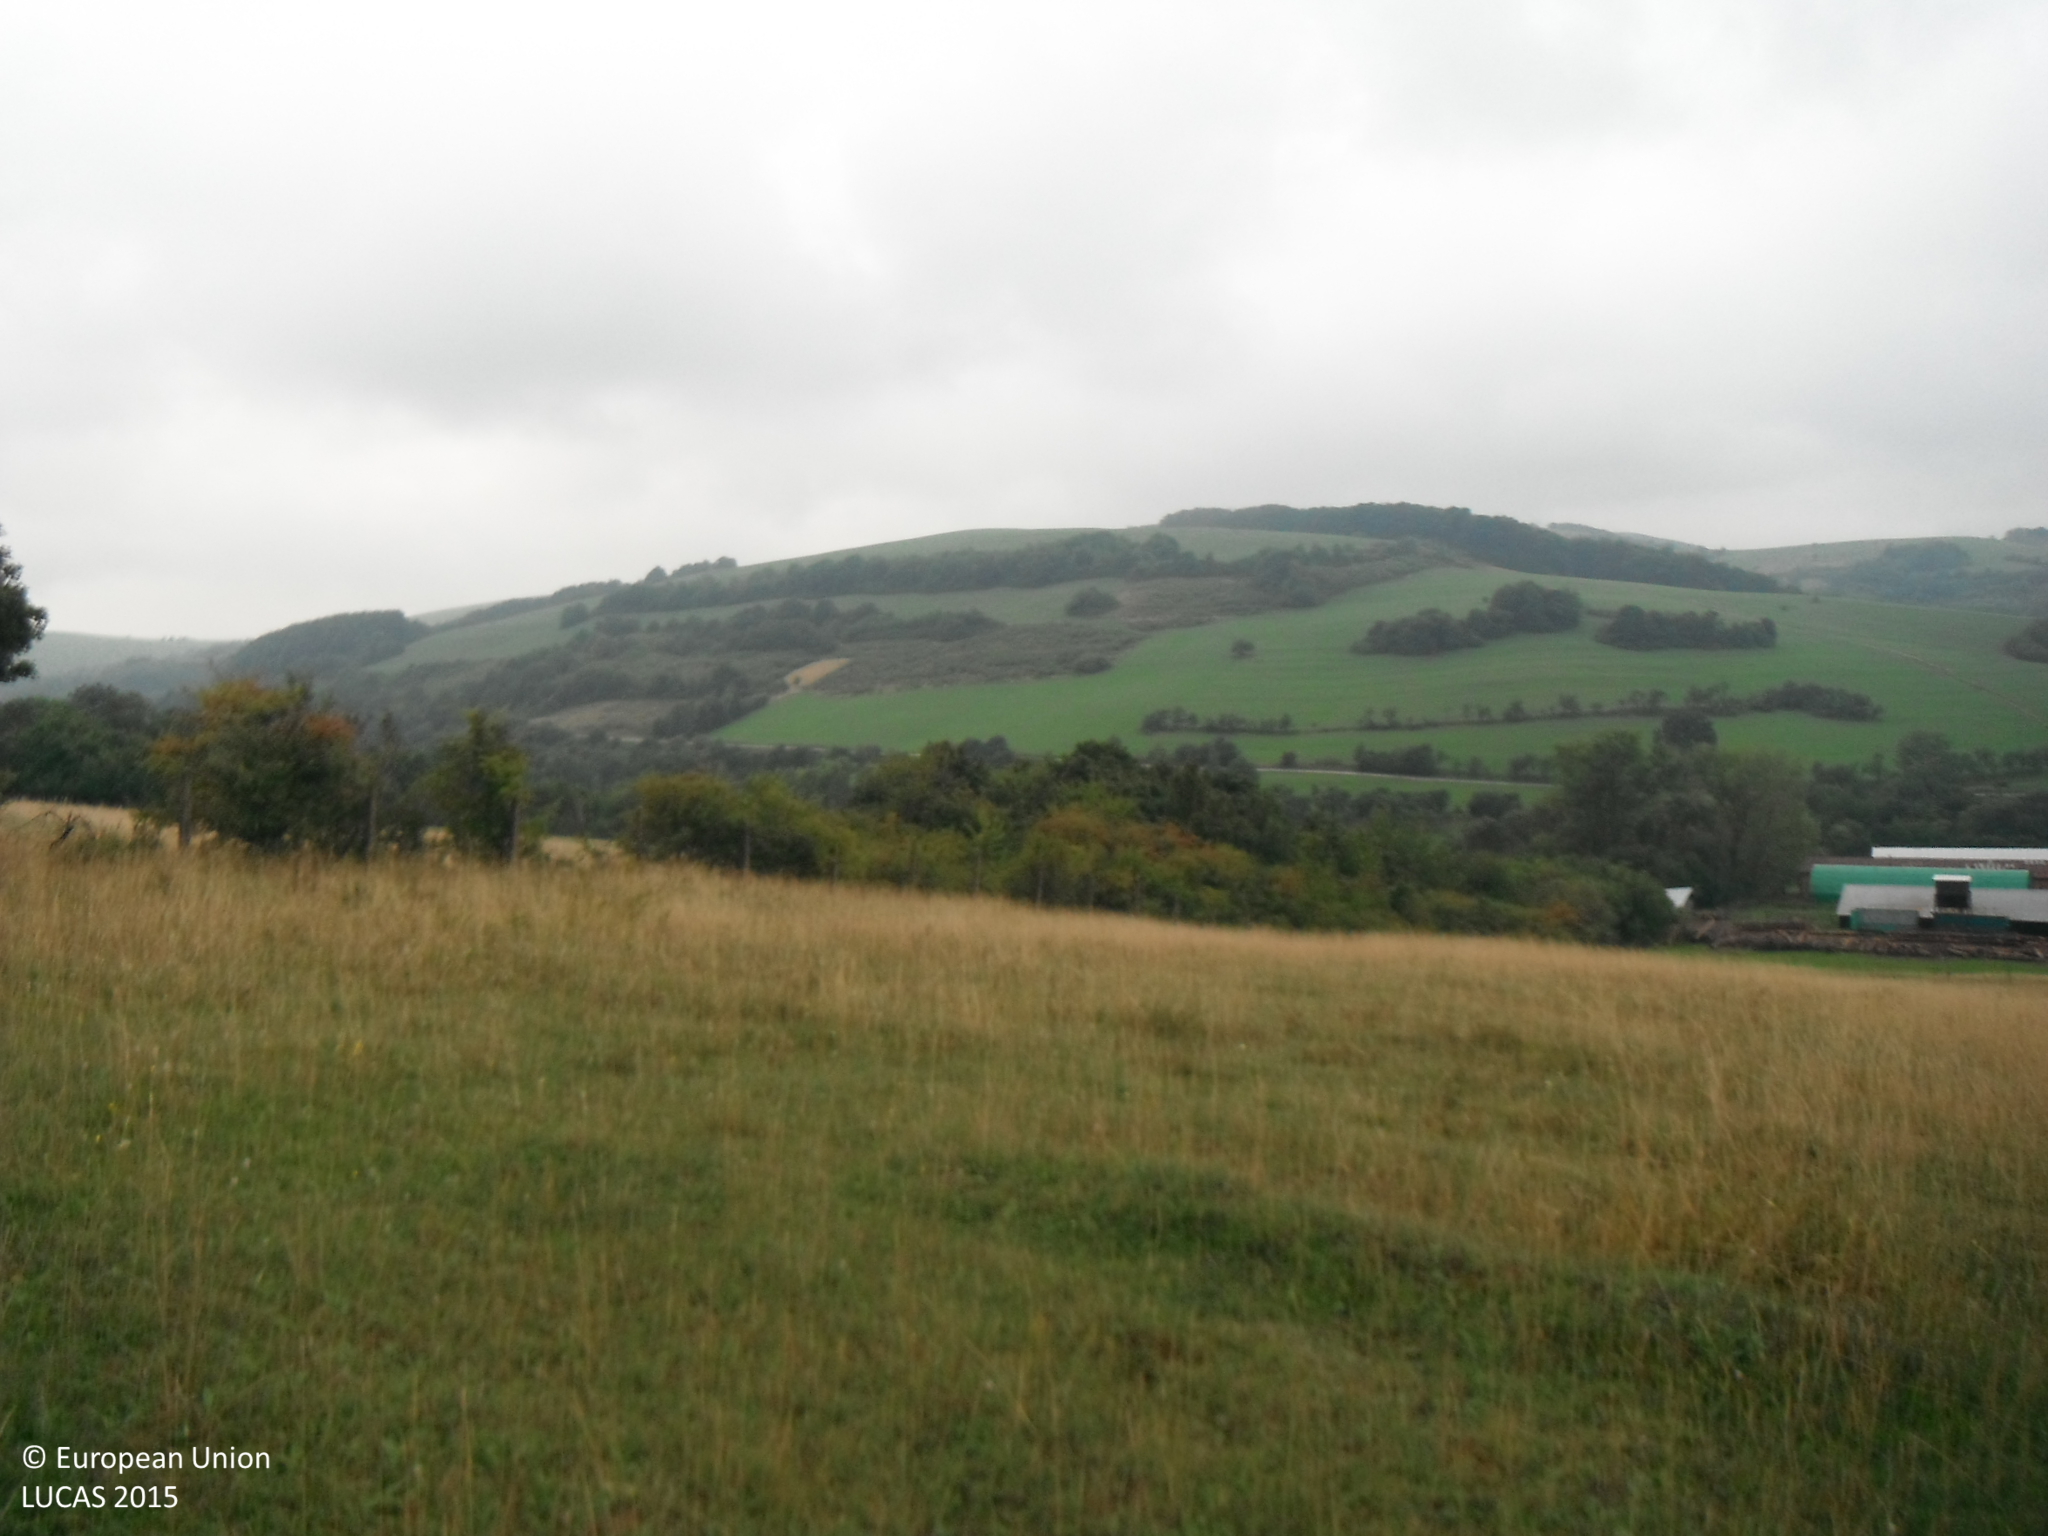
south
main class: Grassland
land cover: Grassland without tree/shrub cover
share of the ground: > 75 %
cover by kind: herbaceous plants 95 %, shrubs 5 %
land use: Agriculture (excluding fallow land and kitchen gardens)
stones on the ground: < 10 %
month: September
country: SK
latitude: 48.8000
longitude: 17.4853
